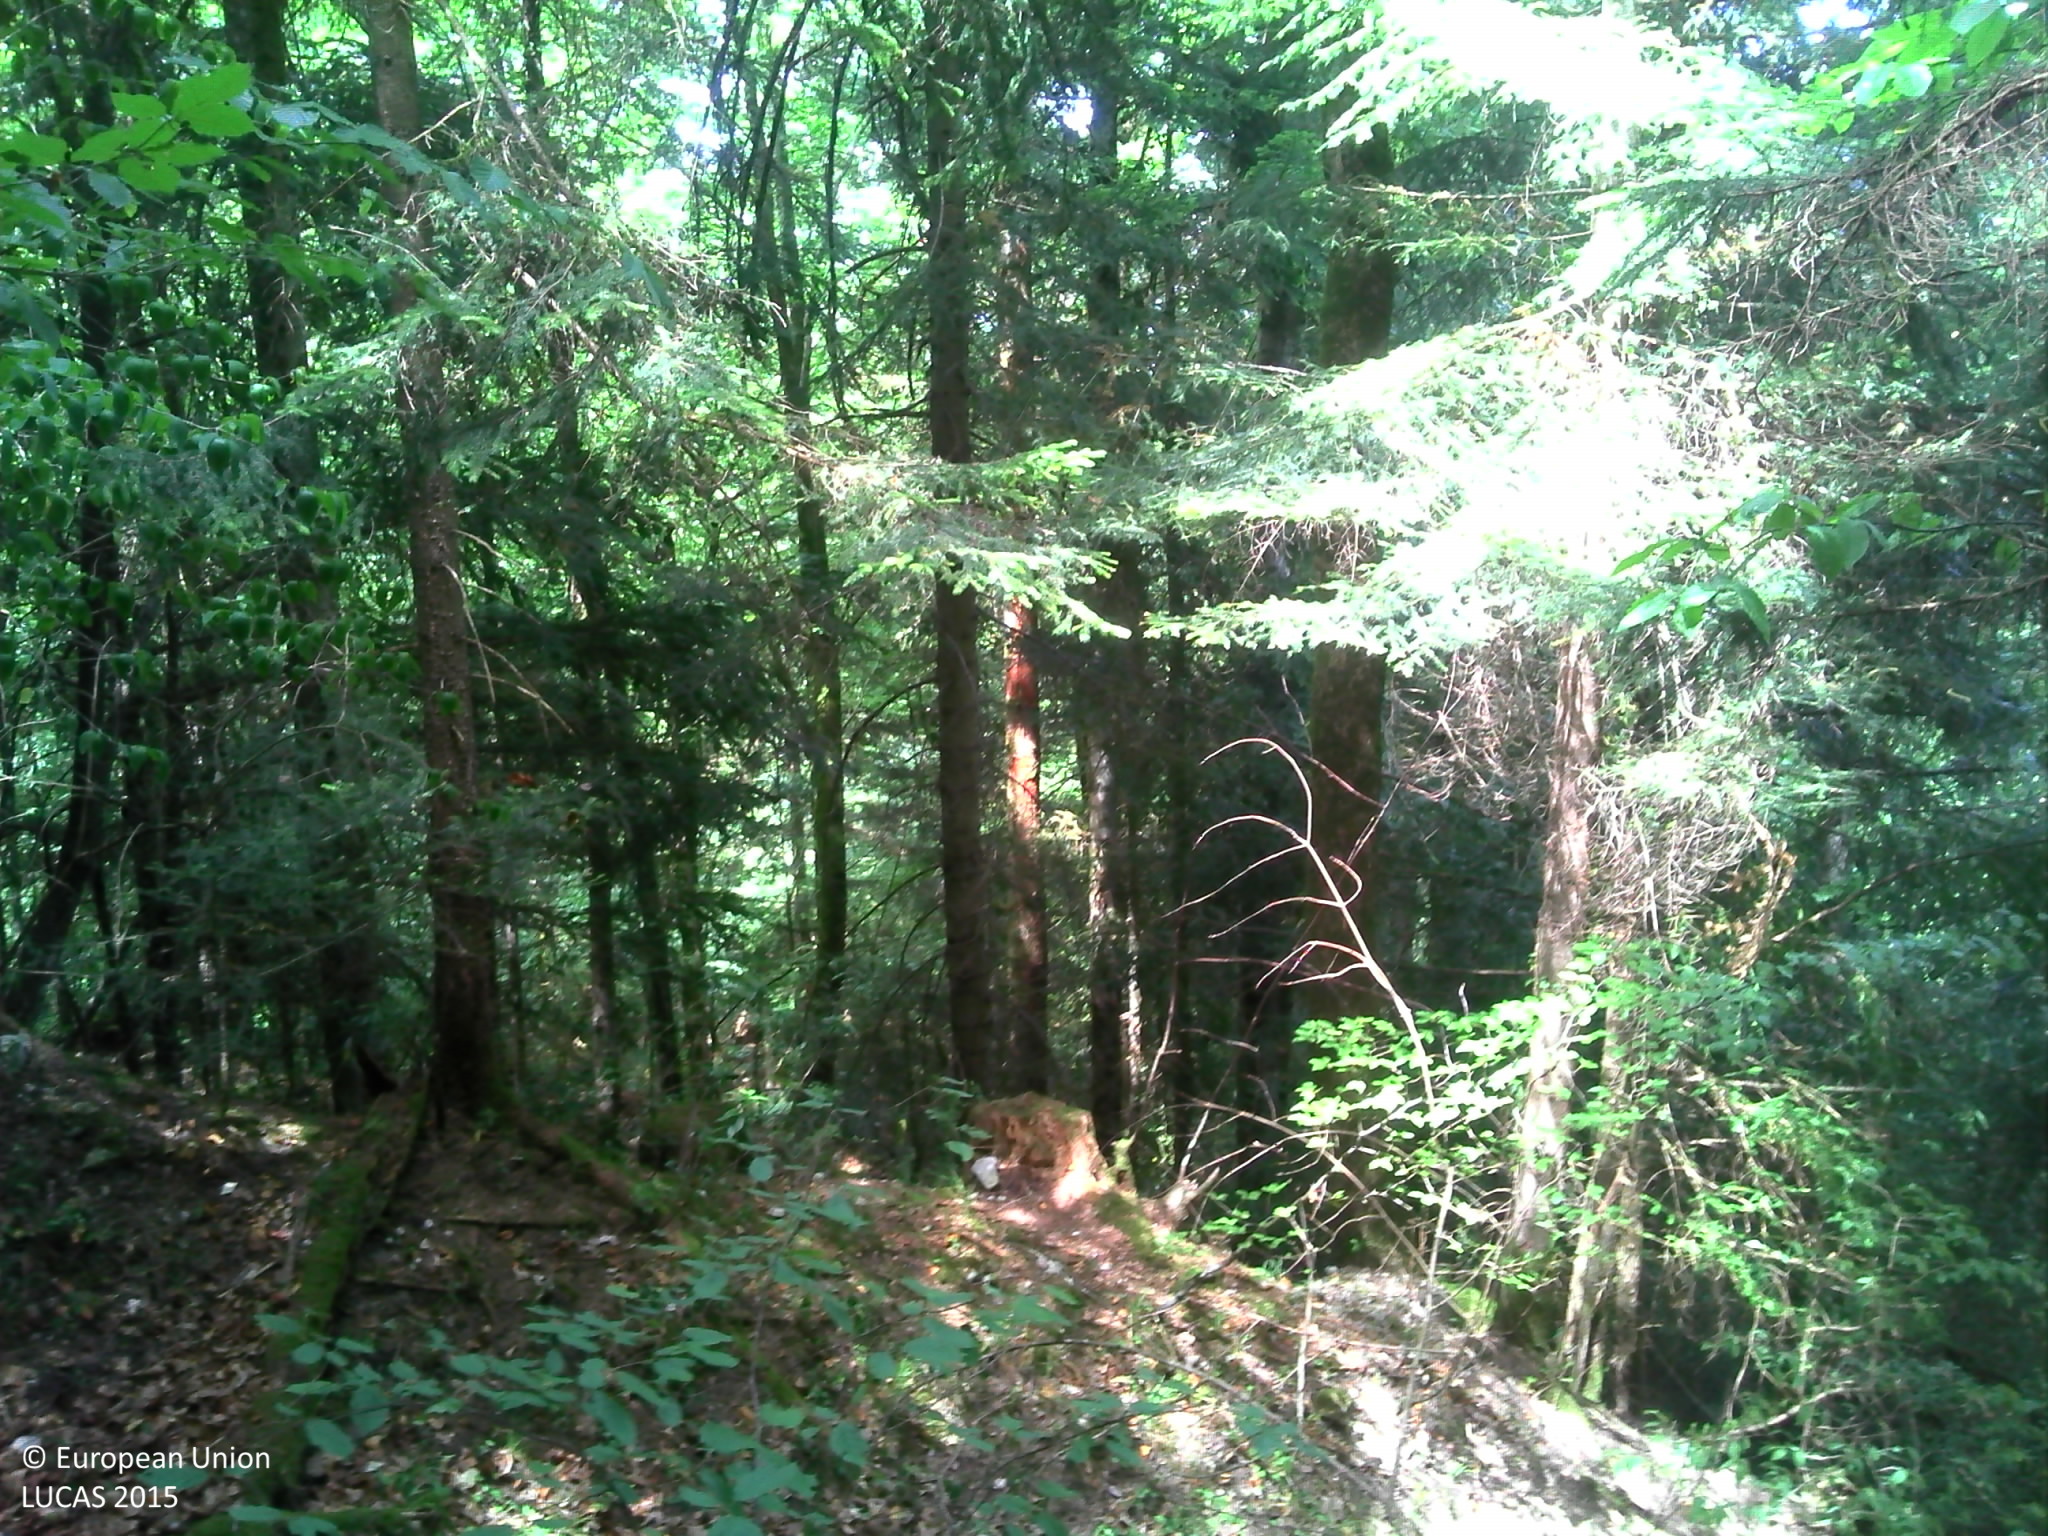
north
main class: Woodland
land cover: Spruce dominated coniferous woodland
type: alpine coniferous forest
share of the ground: > 75 %
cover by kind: coniferous forest trees 60 %, herbaceous plants 20 %, broadleaved forest trees 15 %, lichens and mosses 5 %
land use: Forestry
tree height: > 5 m
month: July
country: FR
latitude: 45.7611
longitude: 6.2113
